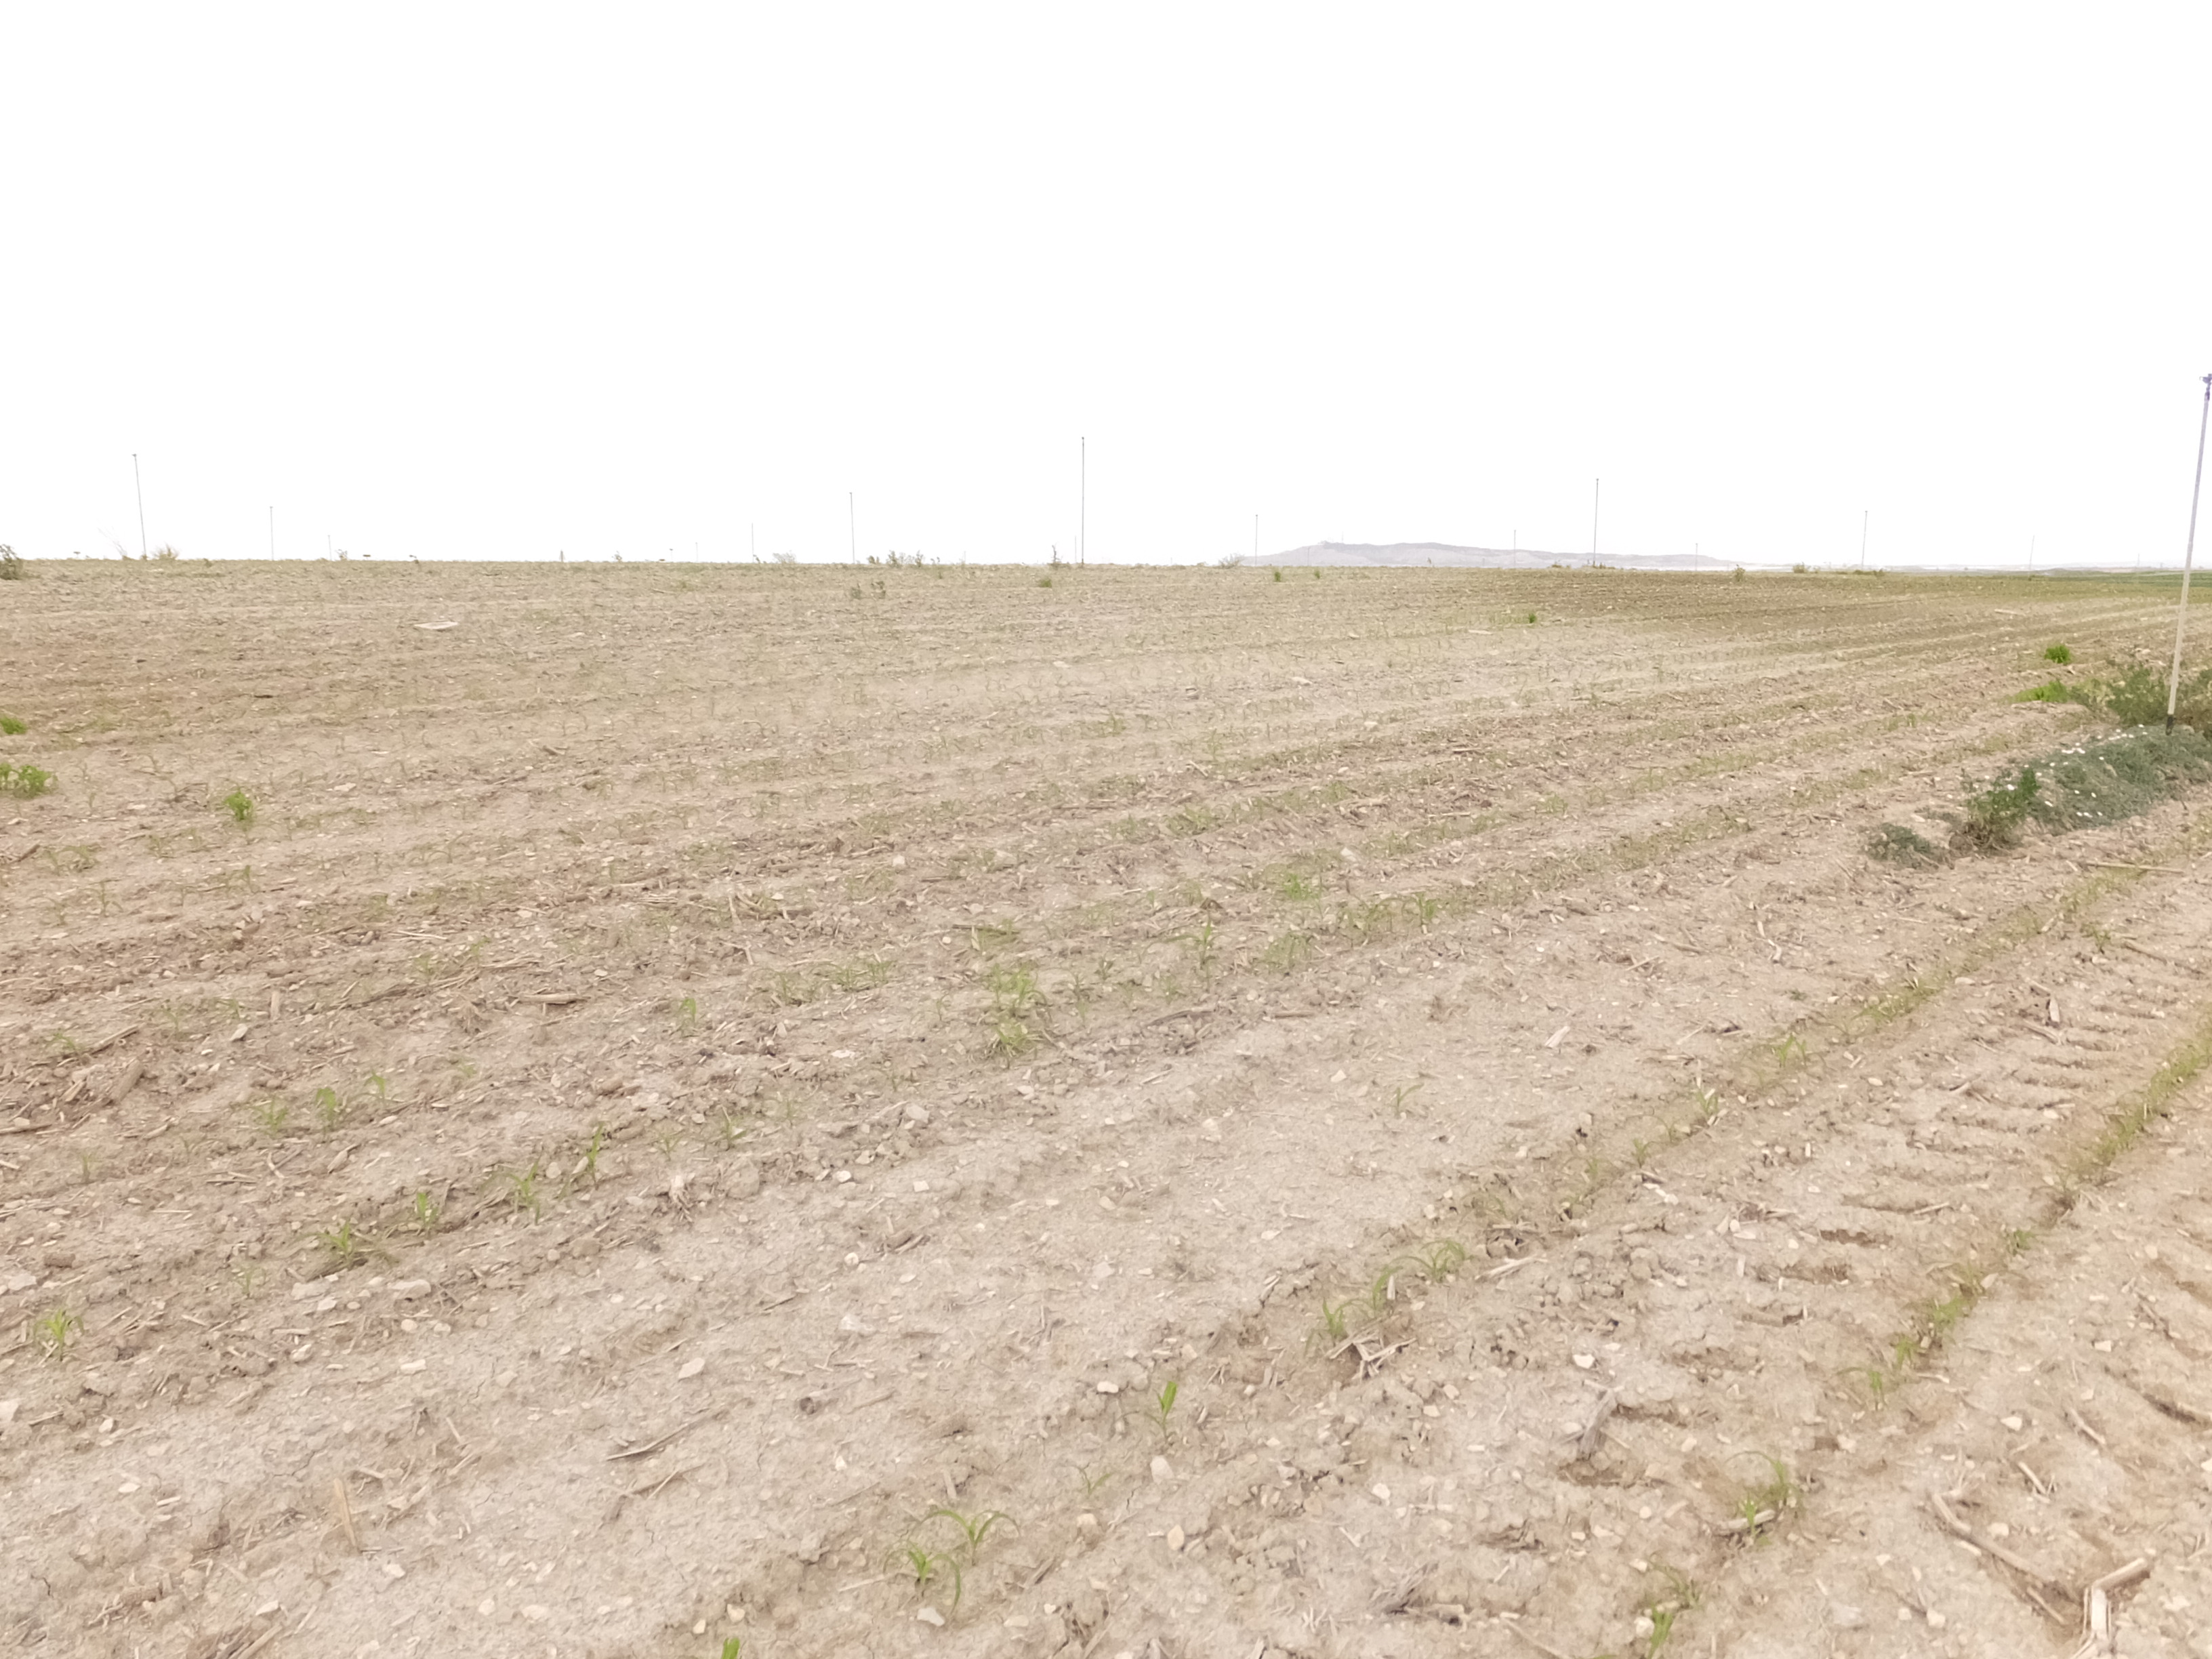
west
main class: Cropland
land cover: Maize
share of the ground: < 10 %
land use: Agriculture (excluding fallow land and kitchen gardens)
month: May
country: ES
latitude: 41.5454
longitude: -0.1214
